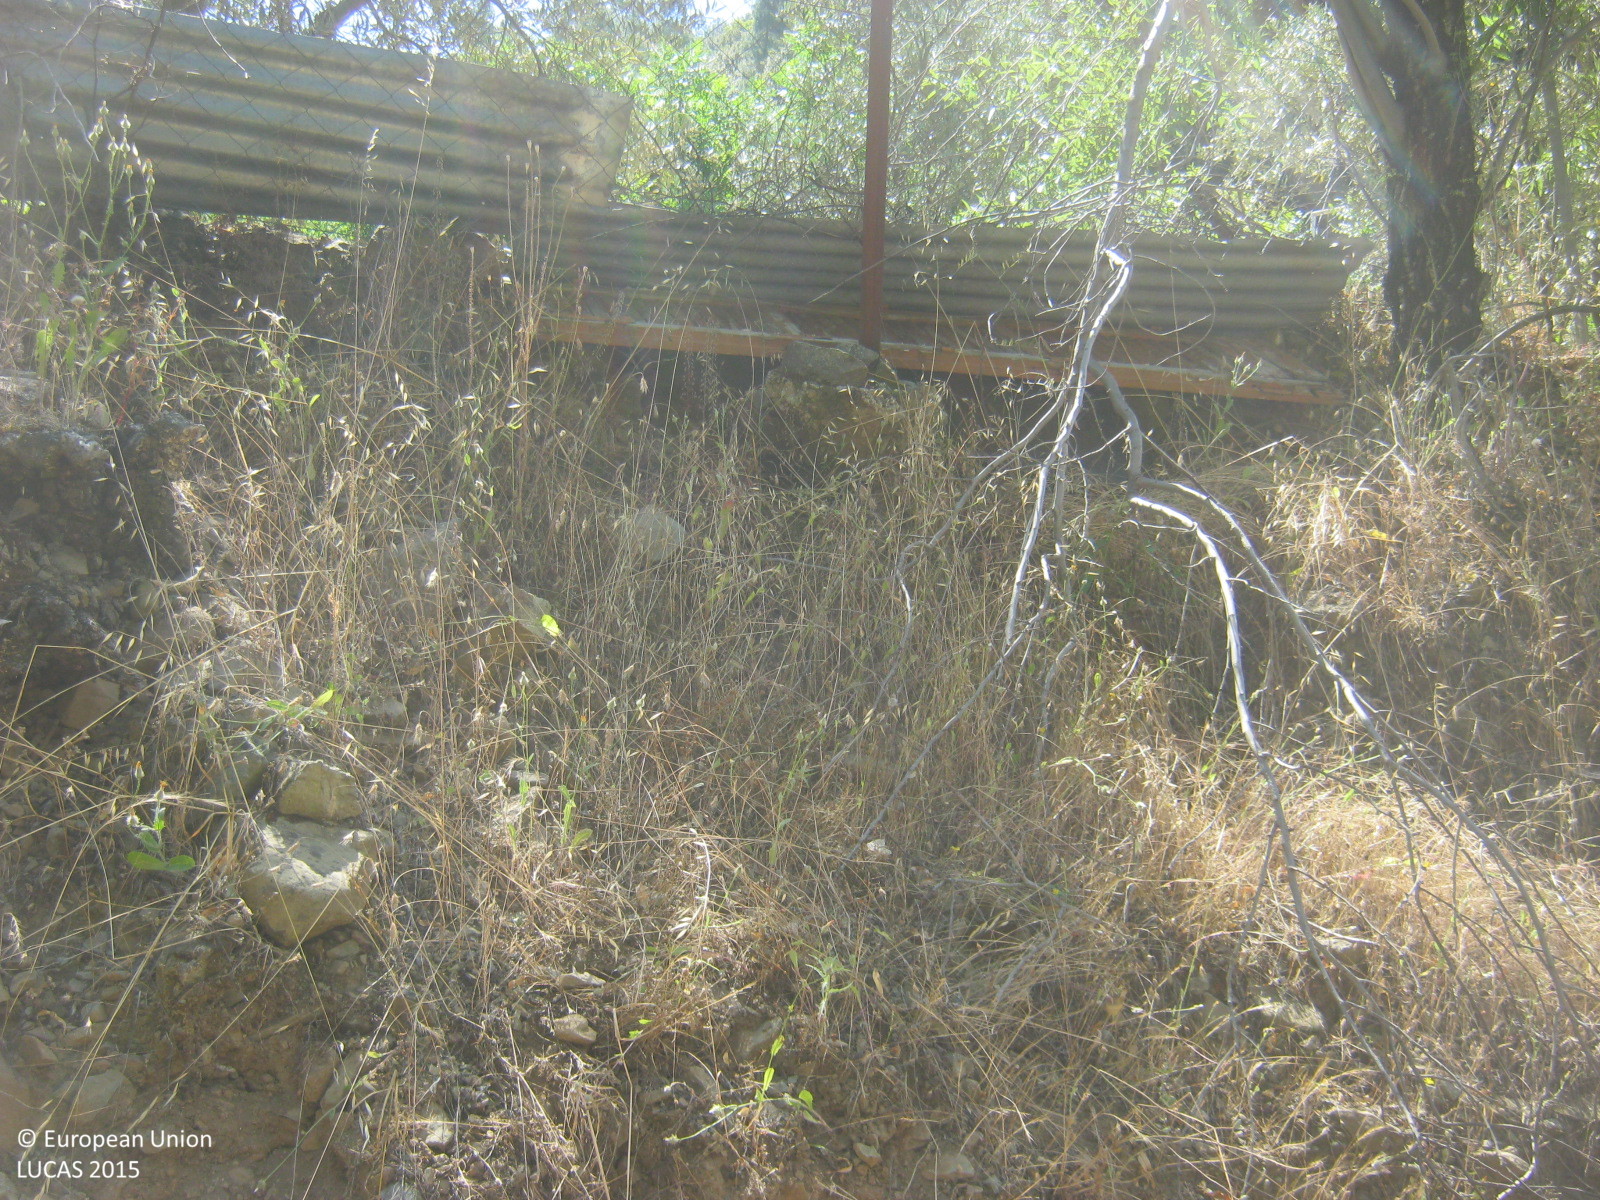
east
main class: Cropland
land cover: Olive groves
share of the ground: 50 - 75 %
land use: Agriculture (excluding fallow land and kitchen gardens)
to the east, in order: Olive groves; Fences; Grassland without tree/shrub cover; Grassland with sparse tree/shrub cover; Pine dominated coniferous woodland
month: June
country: CY
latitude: 34.9919
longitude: 32.8117
